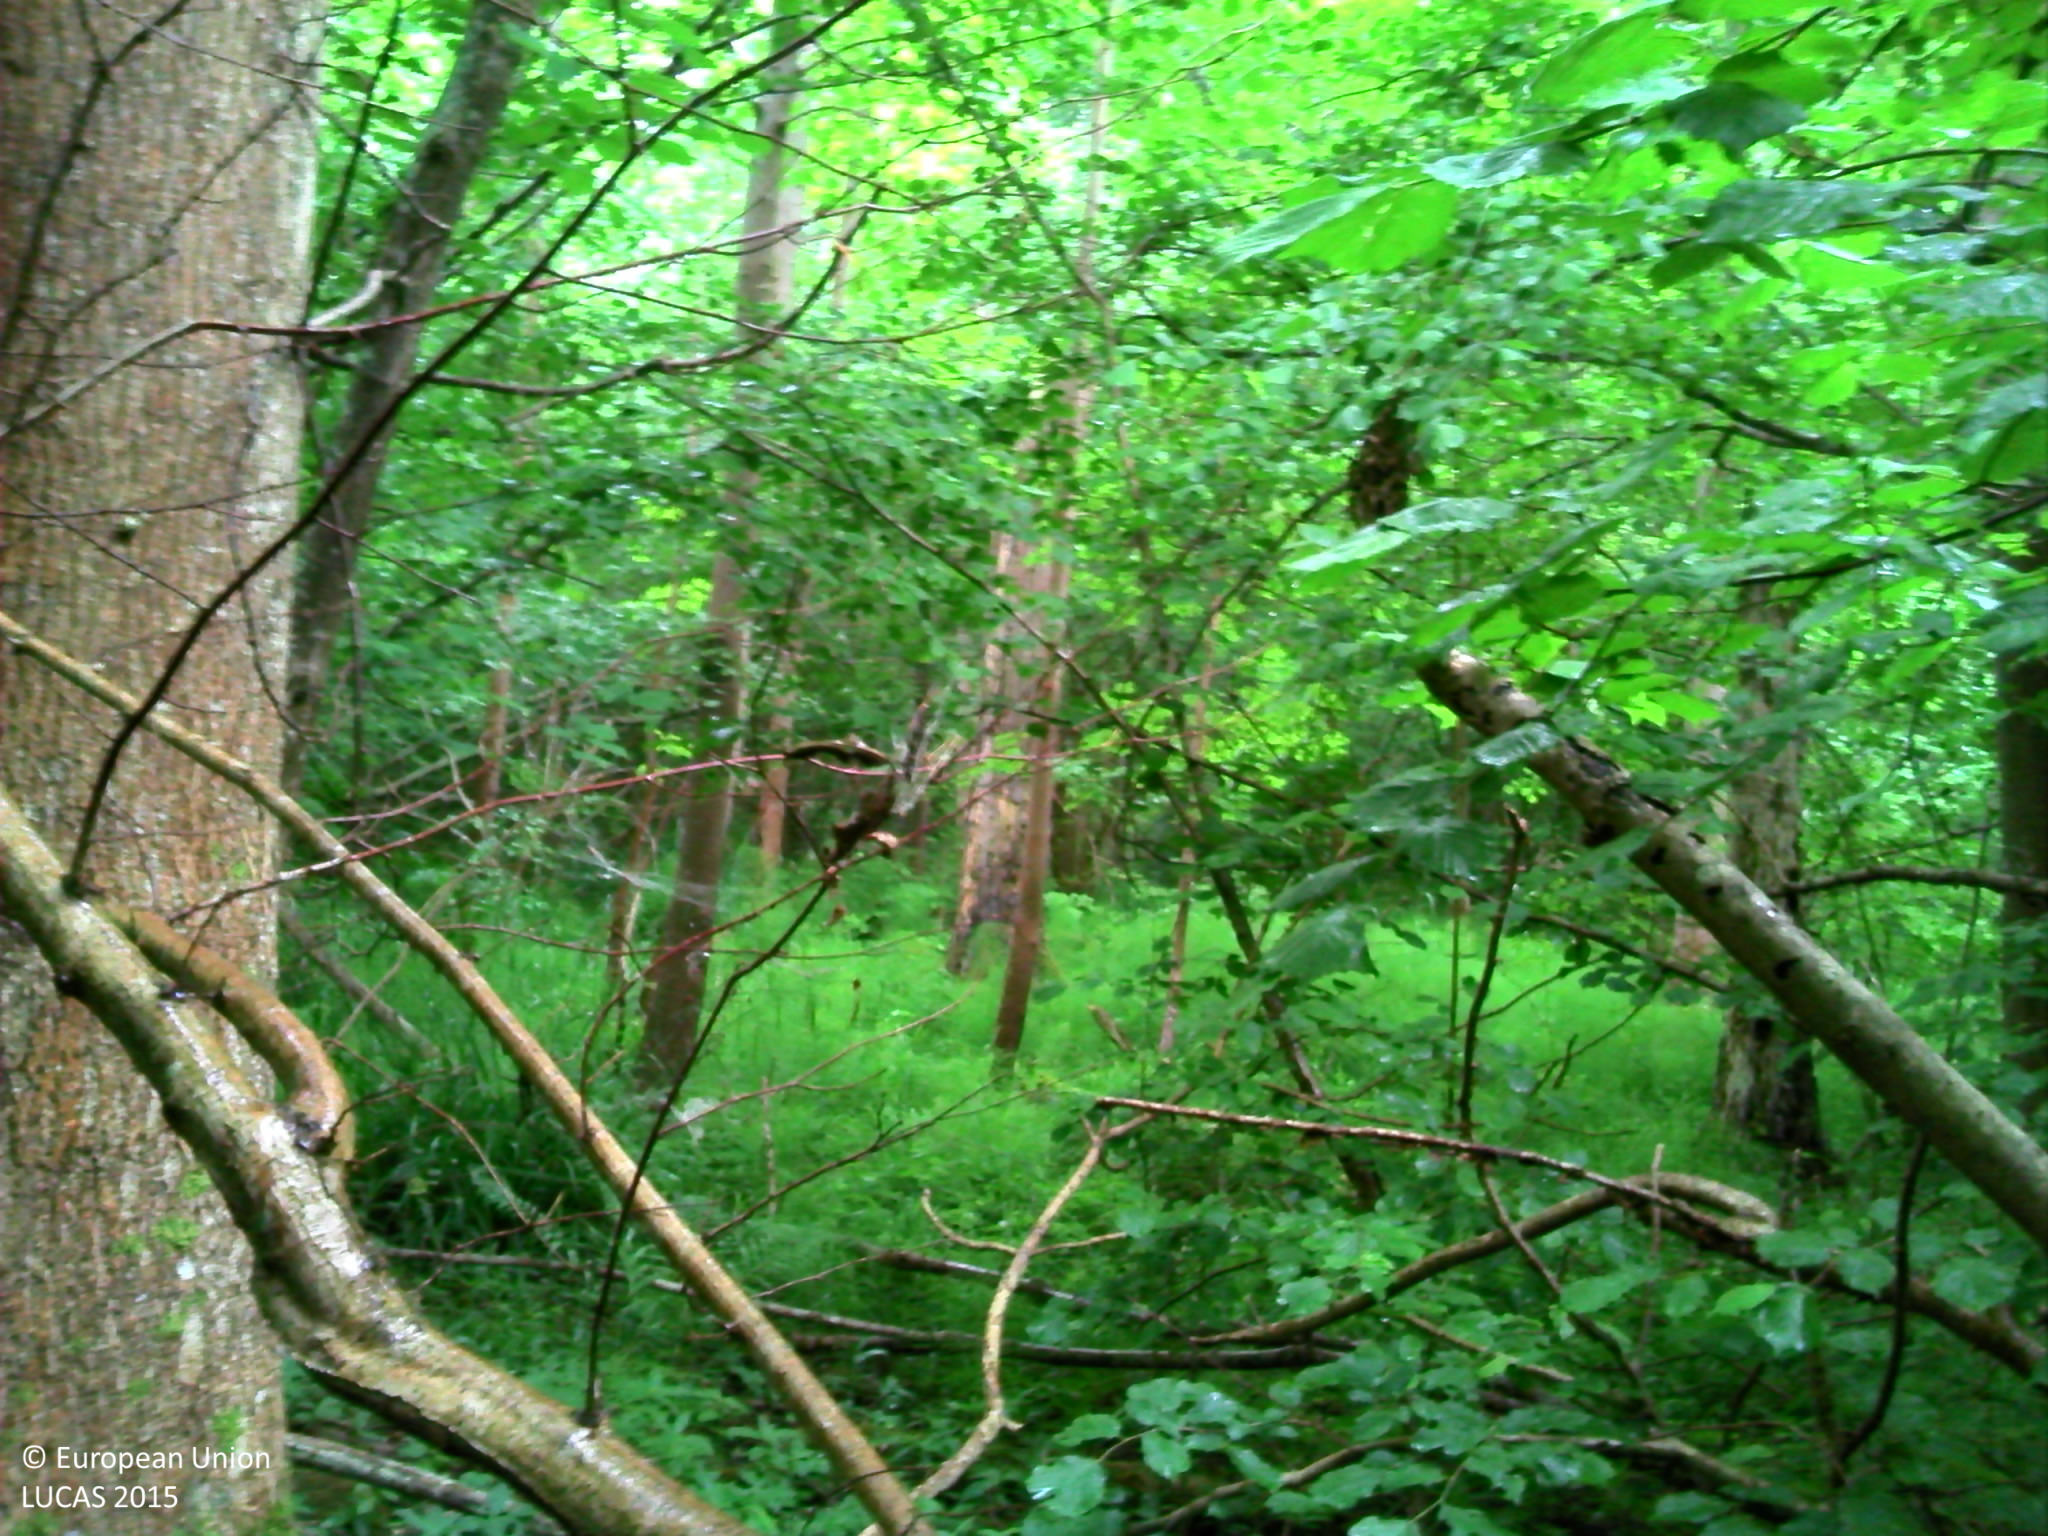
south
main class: Woodland
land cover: Broadleaved woodland
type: acidophilous oak and oak-birch forest
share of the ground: > 75 %
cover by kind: broadleaved forest trees 90 %, shrubs 5 %, herbaceous plants 5 %
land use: Forestry
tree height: > 5 m
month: June
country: FR
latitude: 49.3276
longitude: 2.8488
